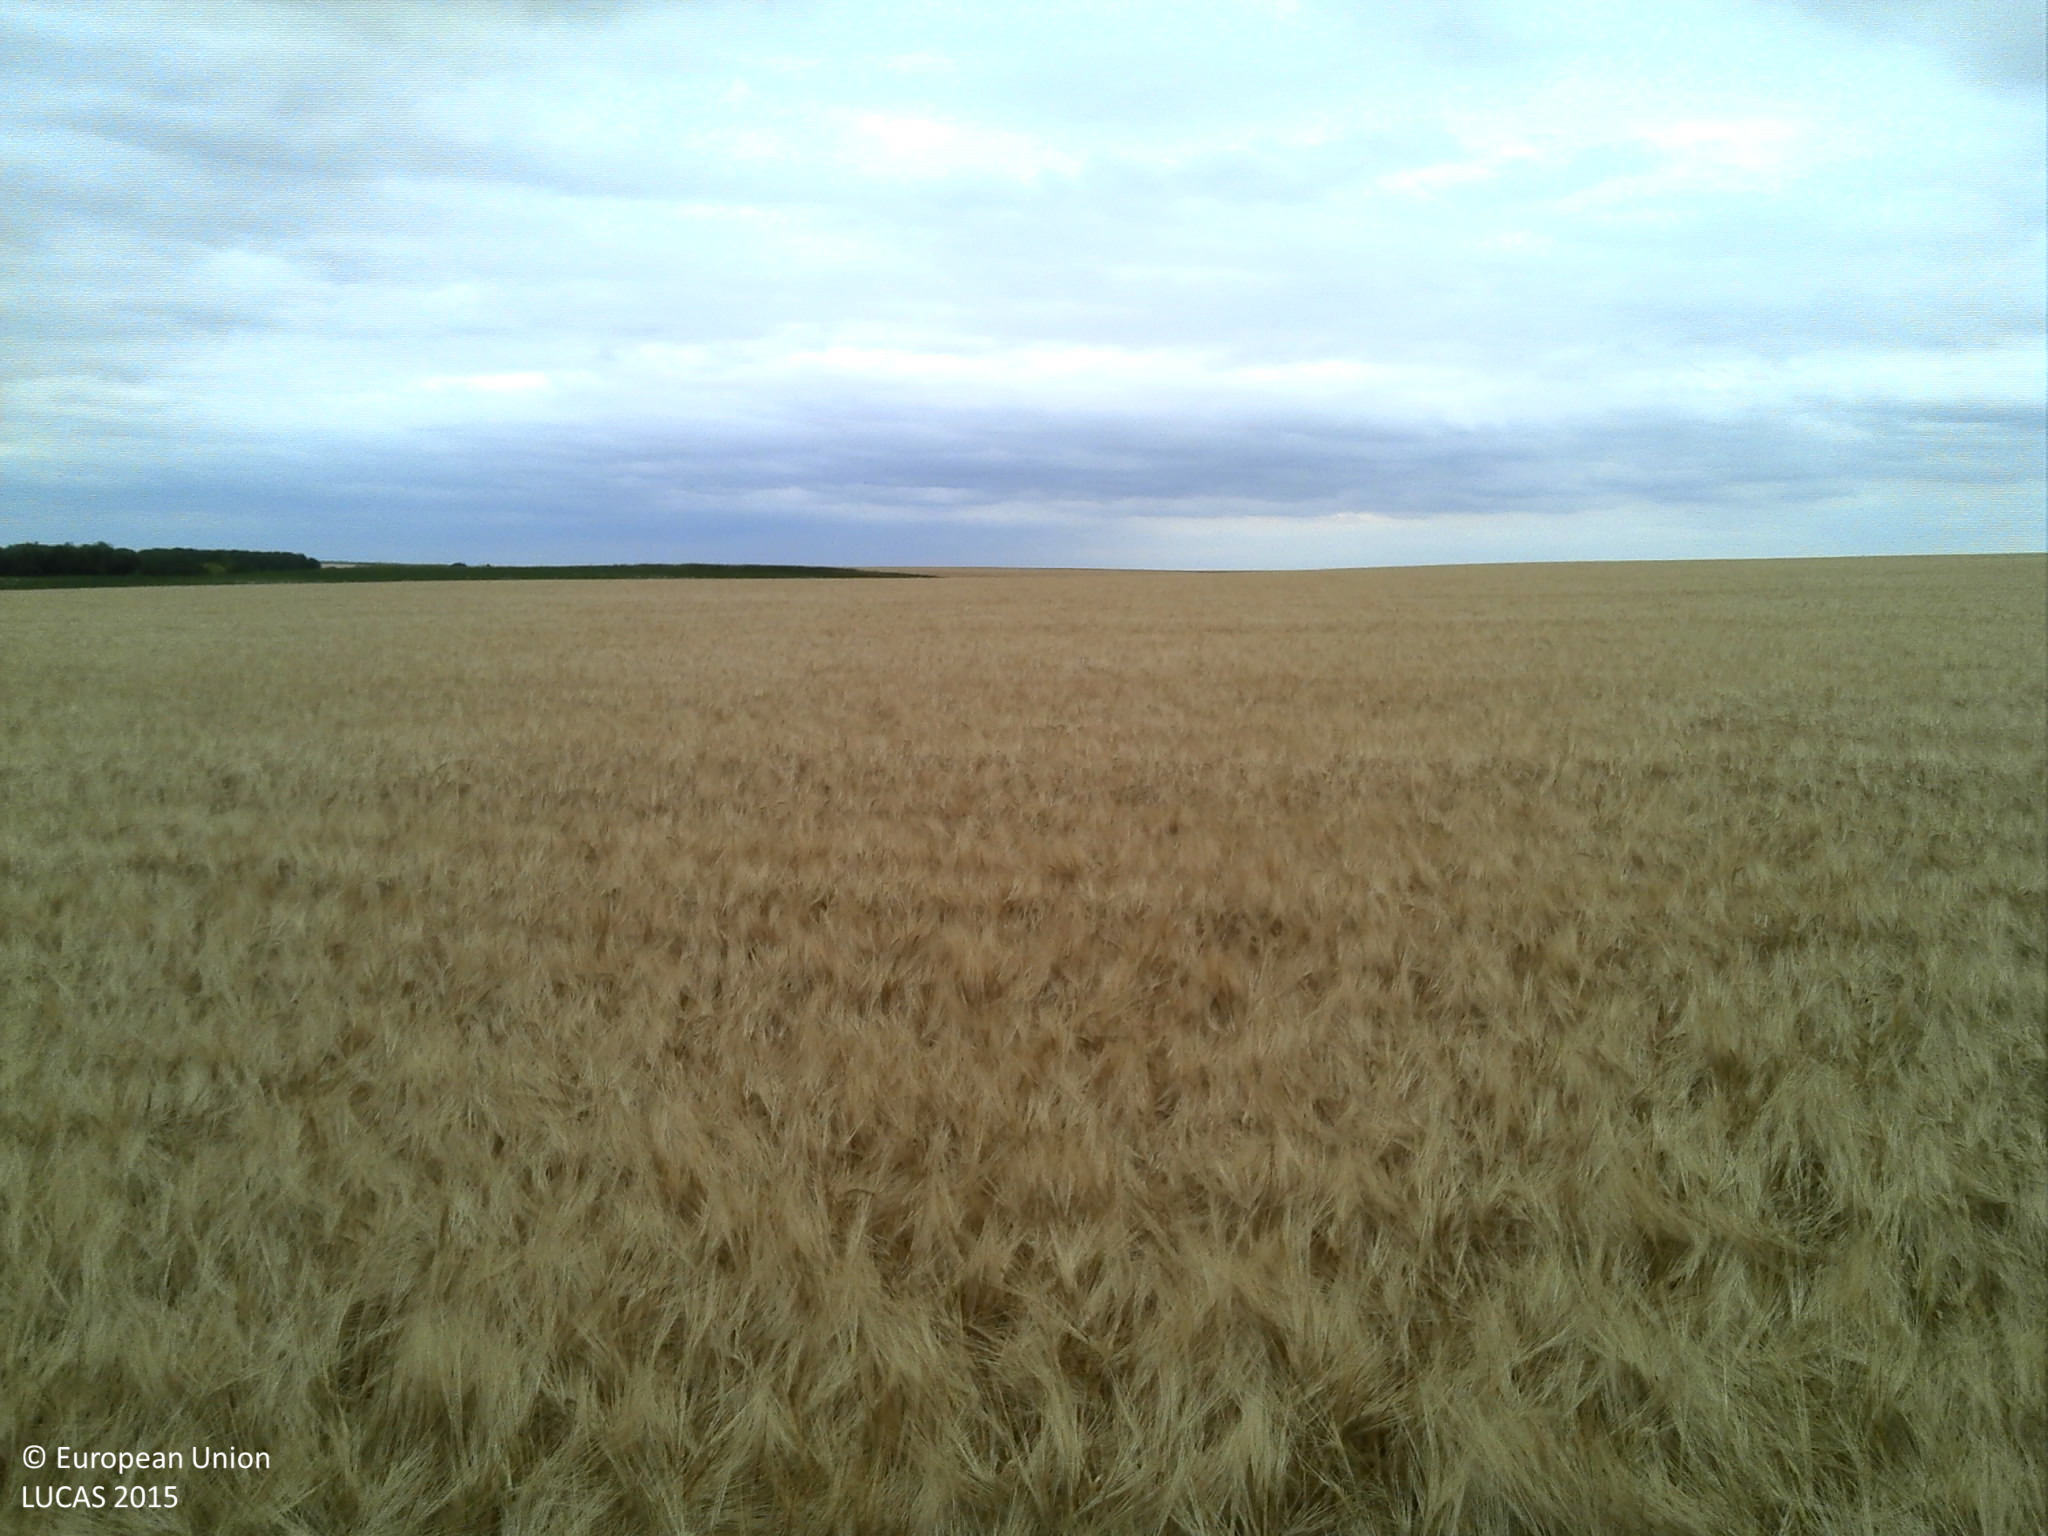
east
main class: Cropland
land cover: Barley
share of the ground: > 75 %
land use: Agriculture (excluding fallow land and kitchen gardens)
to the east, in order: Barley; Sugar beet
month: July
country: FR
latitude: 49.4094
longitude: 4.2759
